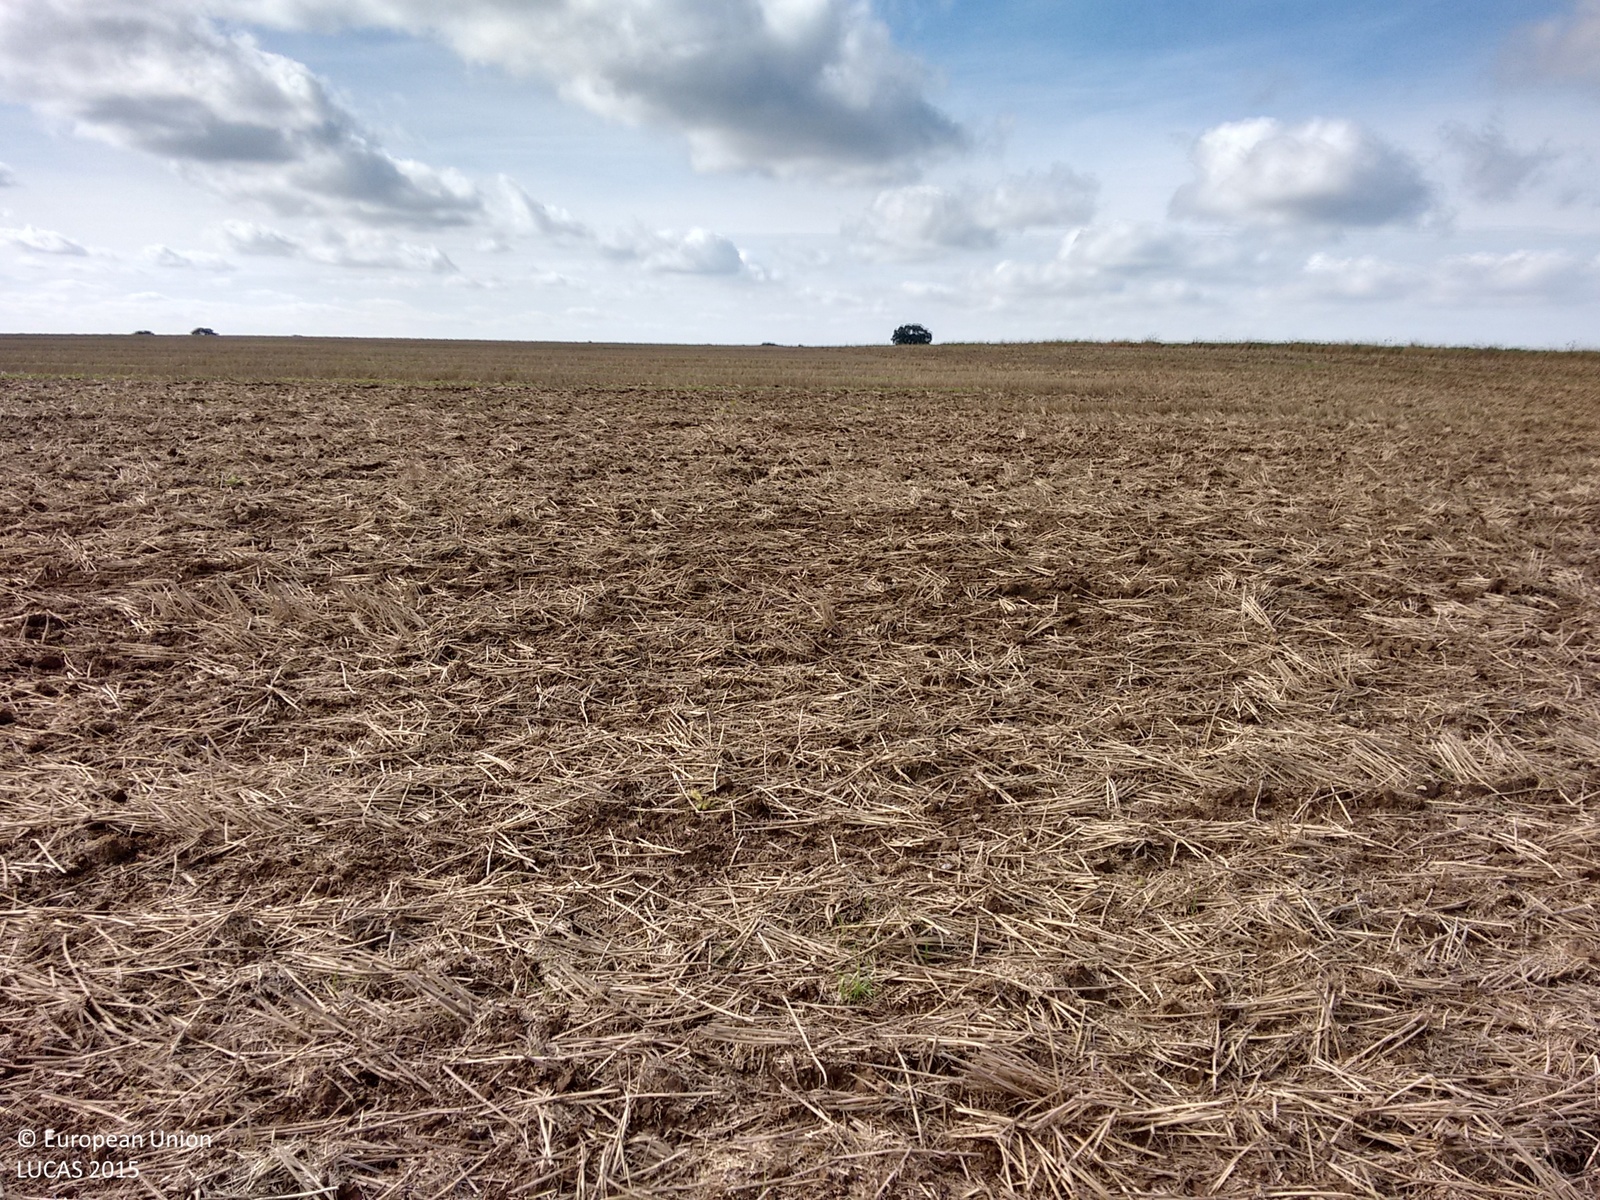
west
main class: Cropland
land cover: Common wheat
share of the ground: > 75 %
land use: Agriculture (excluding fallow land and kitchen gardens)
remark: Harvested field
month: September
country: GB
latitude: 52.8884
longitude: 1.2851
